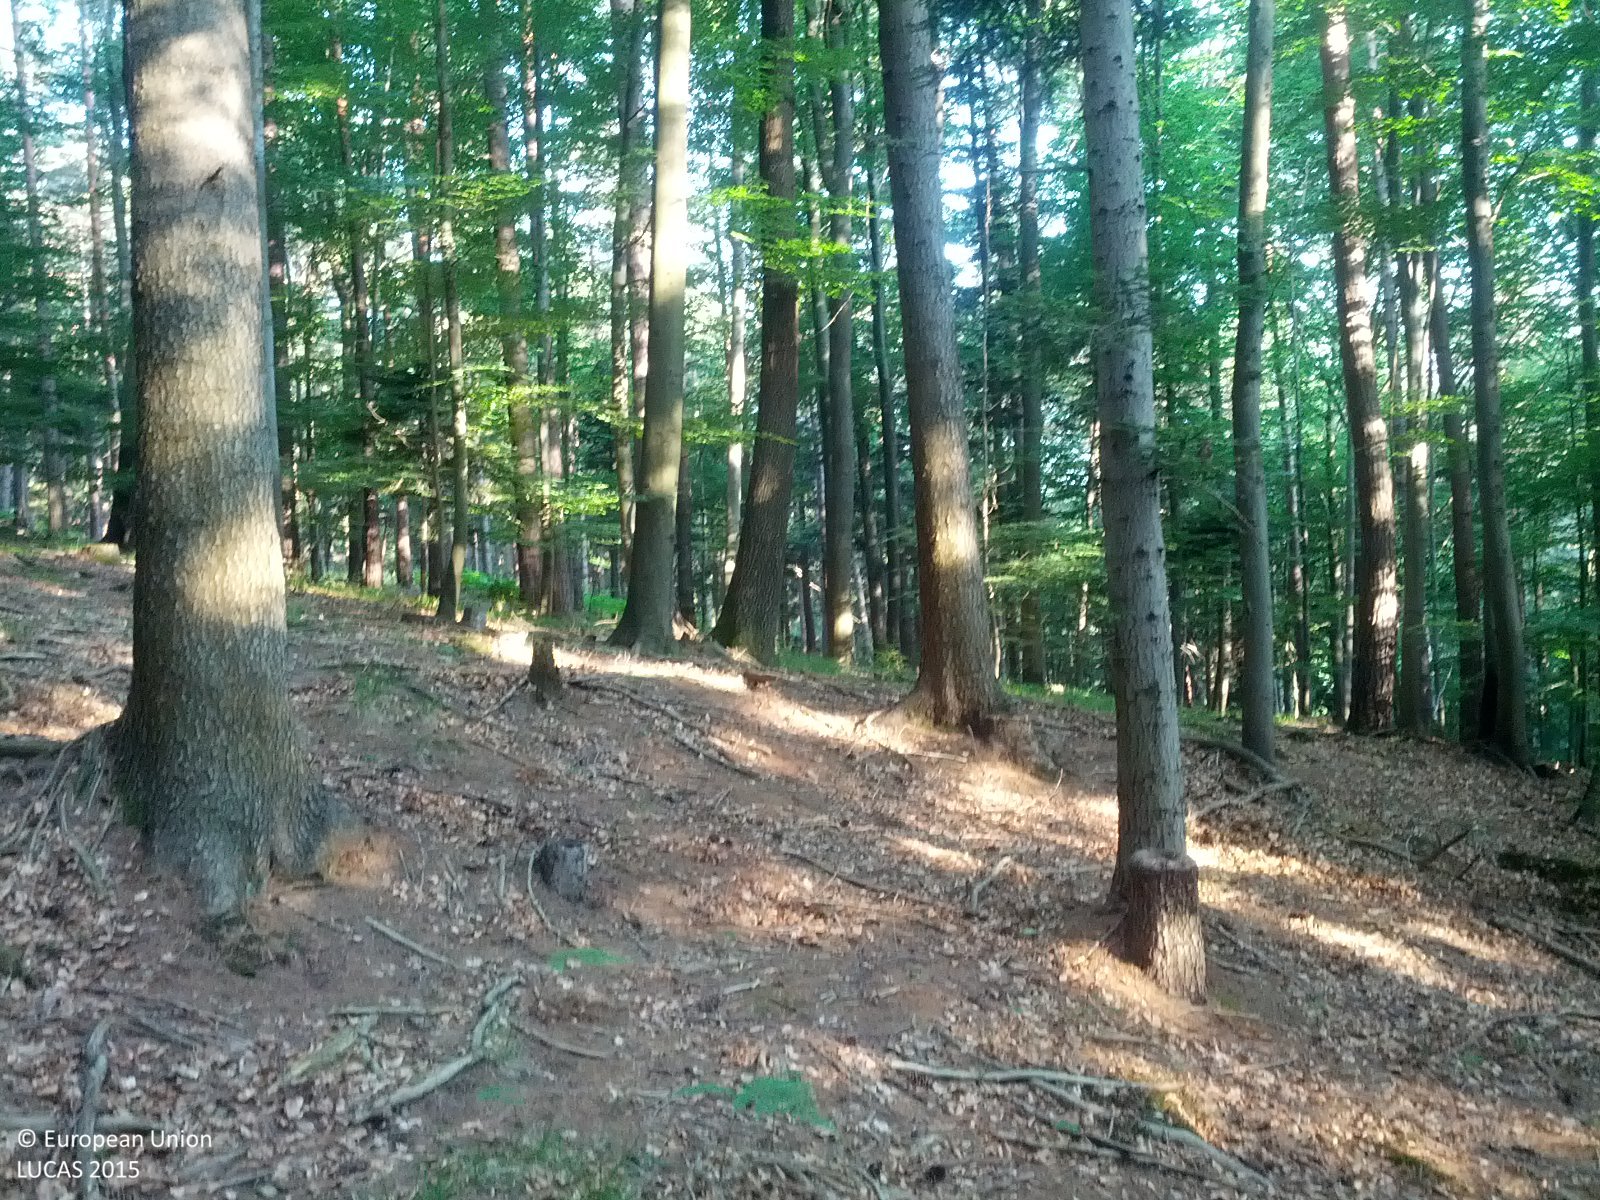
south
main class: Woodland
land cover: Pine dominated mixed woodland
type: hemiboreal forest and nemoral coniferous forest and mixed broadleaved-coniferous forest
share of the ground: > 75 %
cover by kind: broadleaved forest trees 50 %, coniferous forest trees 40 %, herbaceous plants 5 %, lichens and mosses 5 %
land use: Forestry
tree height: > 5 m
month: June
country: AT
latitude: 48.1841
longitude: 16.0431
